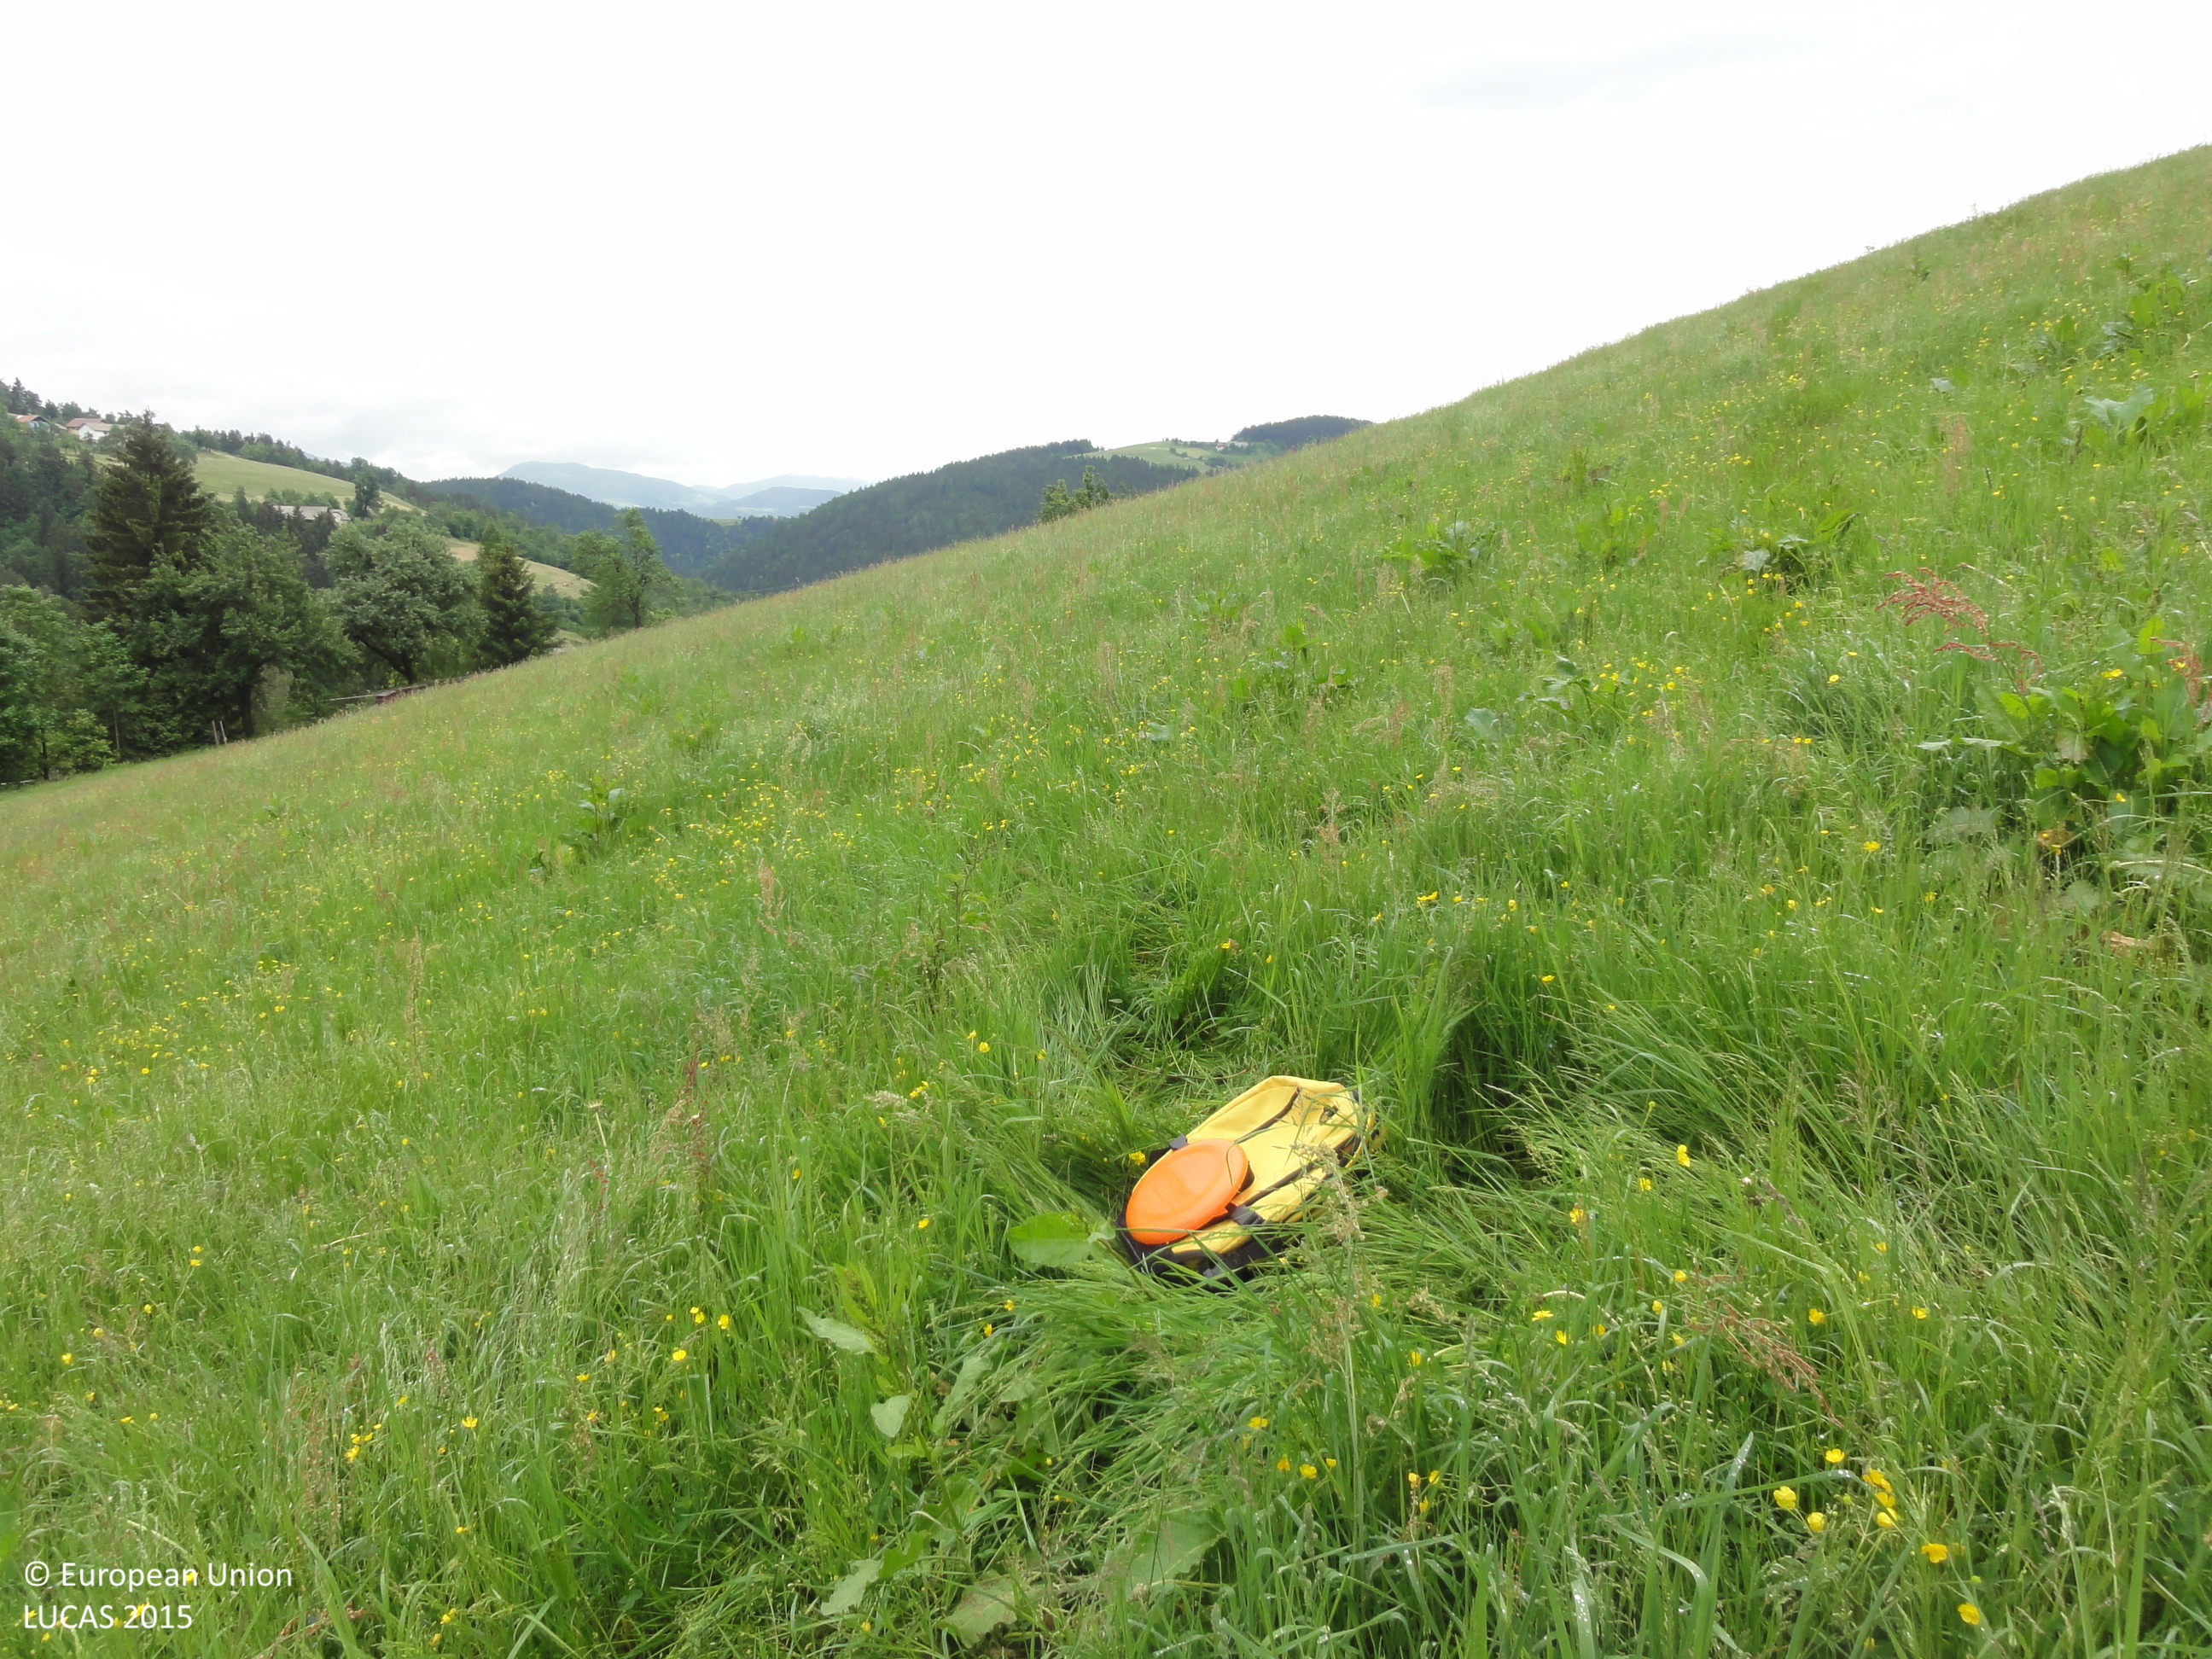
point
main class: Grassland
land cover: Grassland without tree/shrub cover
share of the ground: > 75 %
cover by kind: herbaceous plants 100 %
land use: Agriculture (excluding fallow land and kitchen gardens)
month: May
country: SI
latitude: 46.5474
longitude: 14.8623
